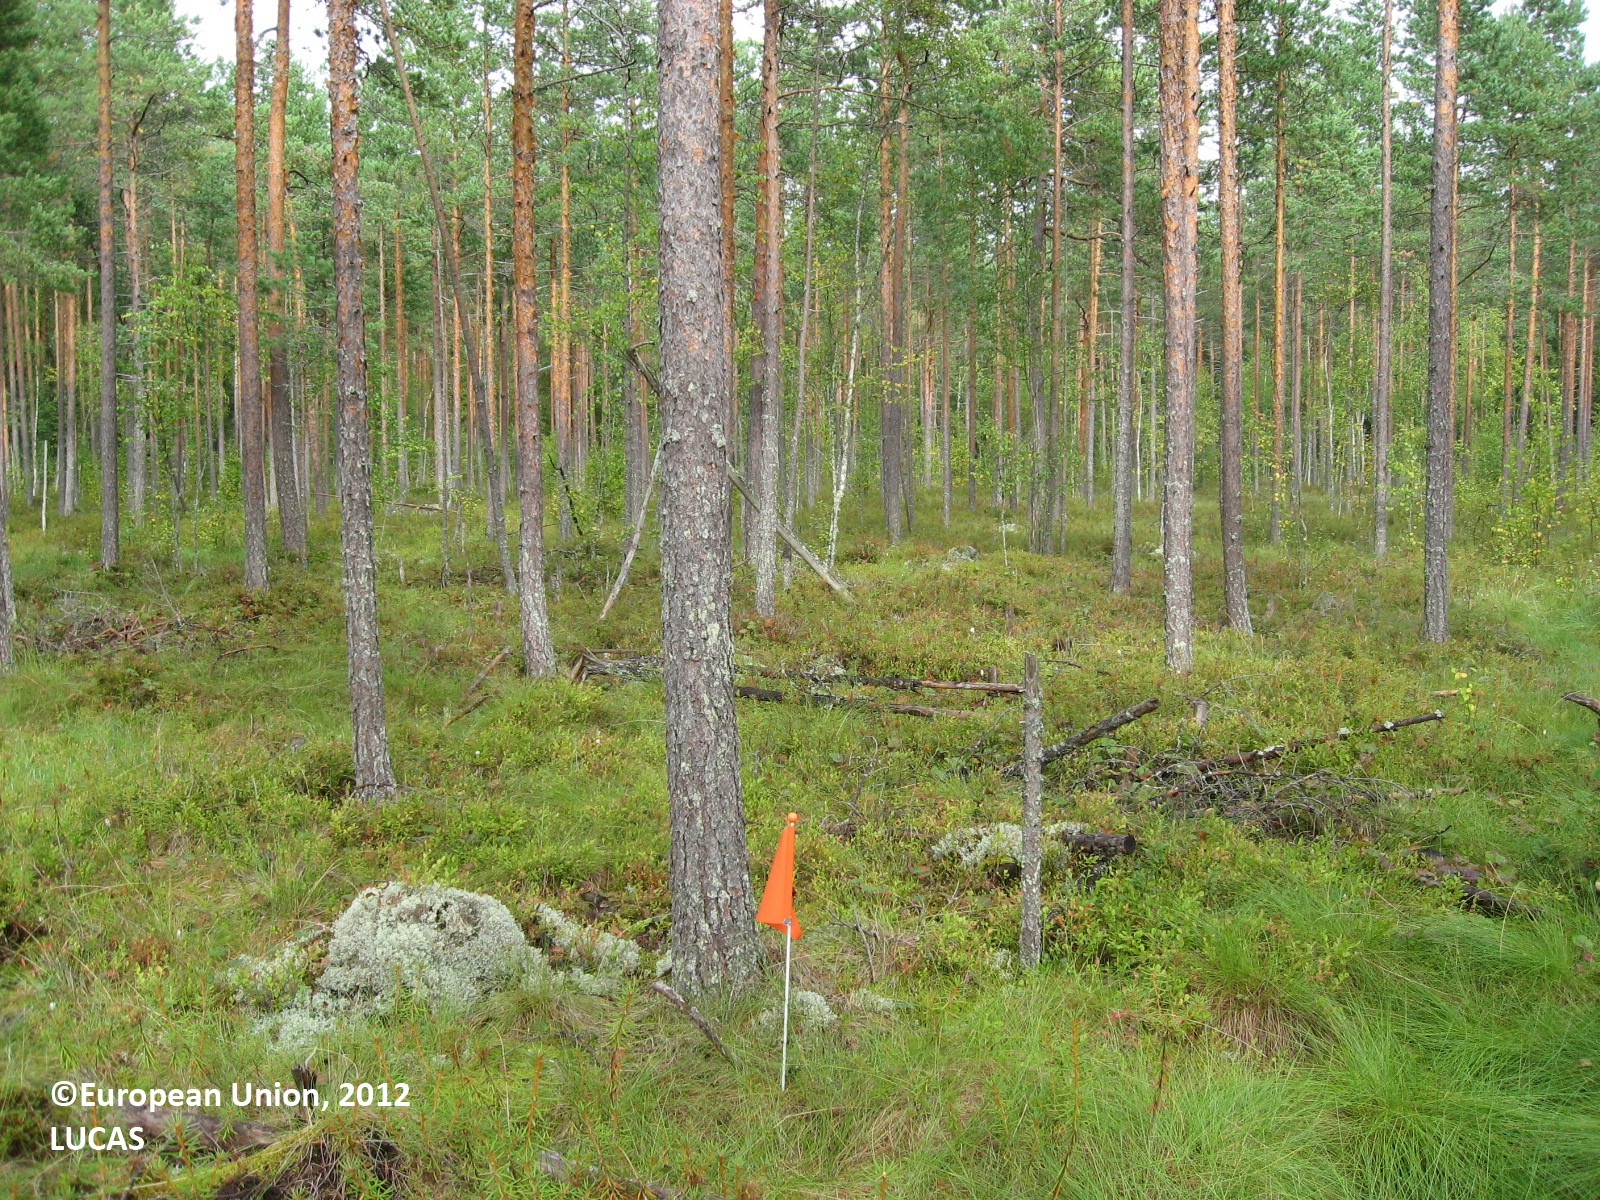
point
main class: Woodland
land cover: Pine dominated coniferous woodland
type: boreal forest
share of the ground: 50 - 75 %
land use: Forestry
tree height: > 5 m
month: August
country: FI
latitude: 61.5265
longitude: 24.7894
